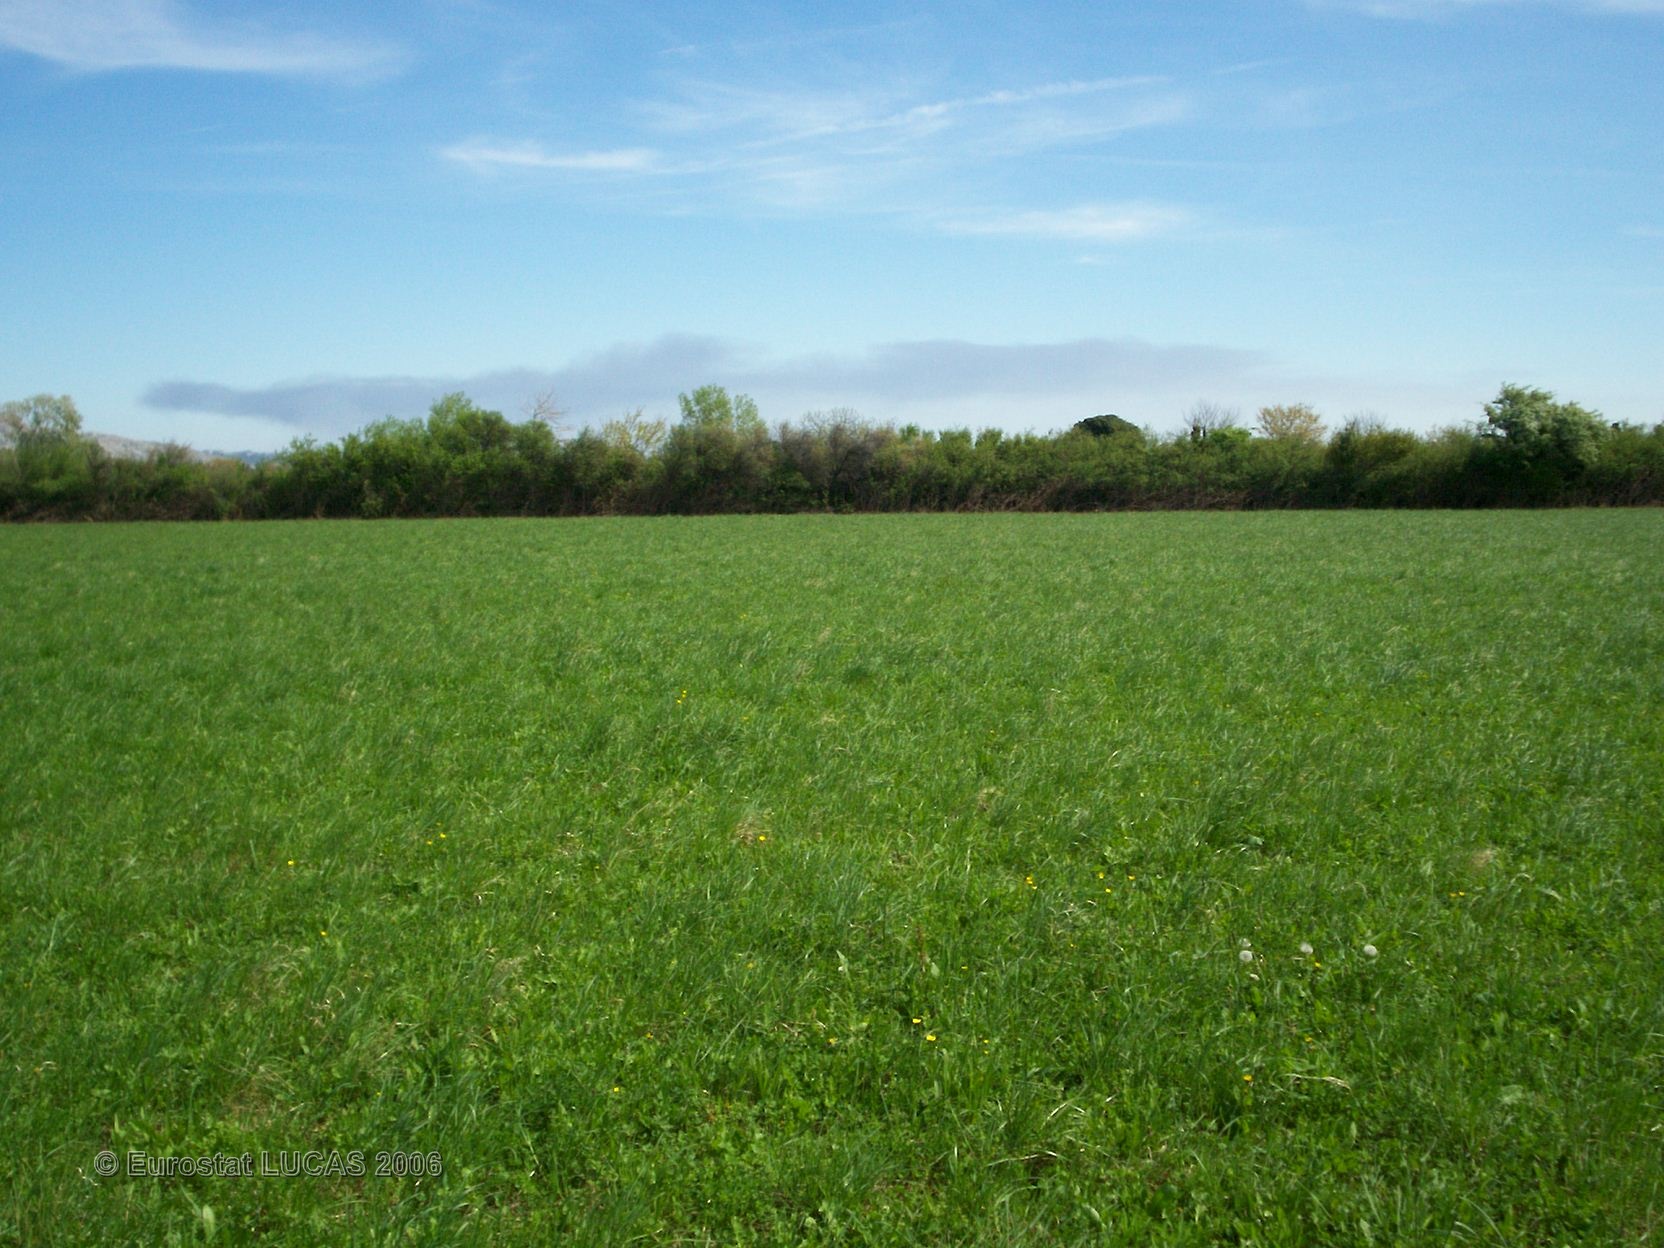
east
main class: Grassland
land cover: Grassland without tree/shrub cover
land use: Agriculture (excluding fallow land and kitchen gardens)
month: April
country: FR
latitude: 43.6835
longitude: 4.9109
